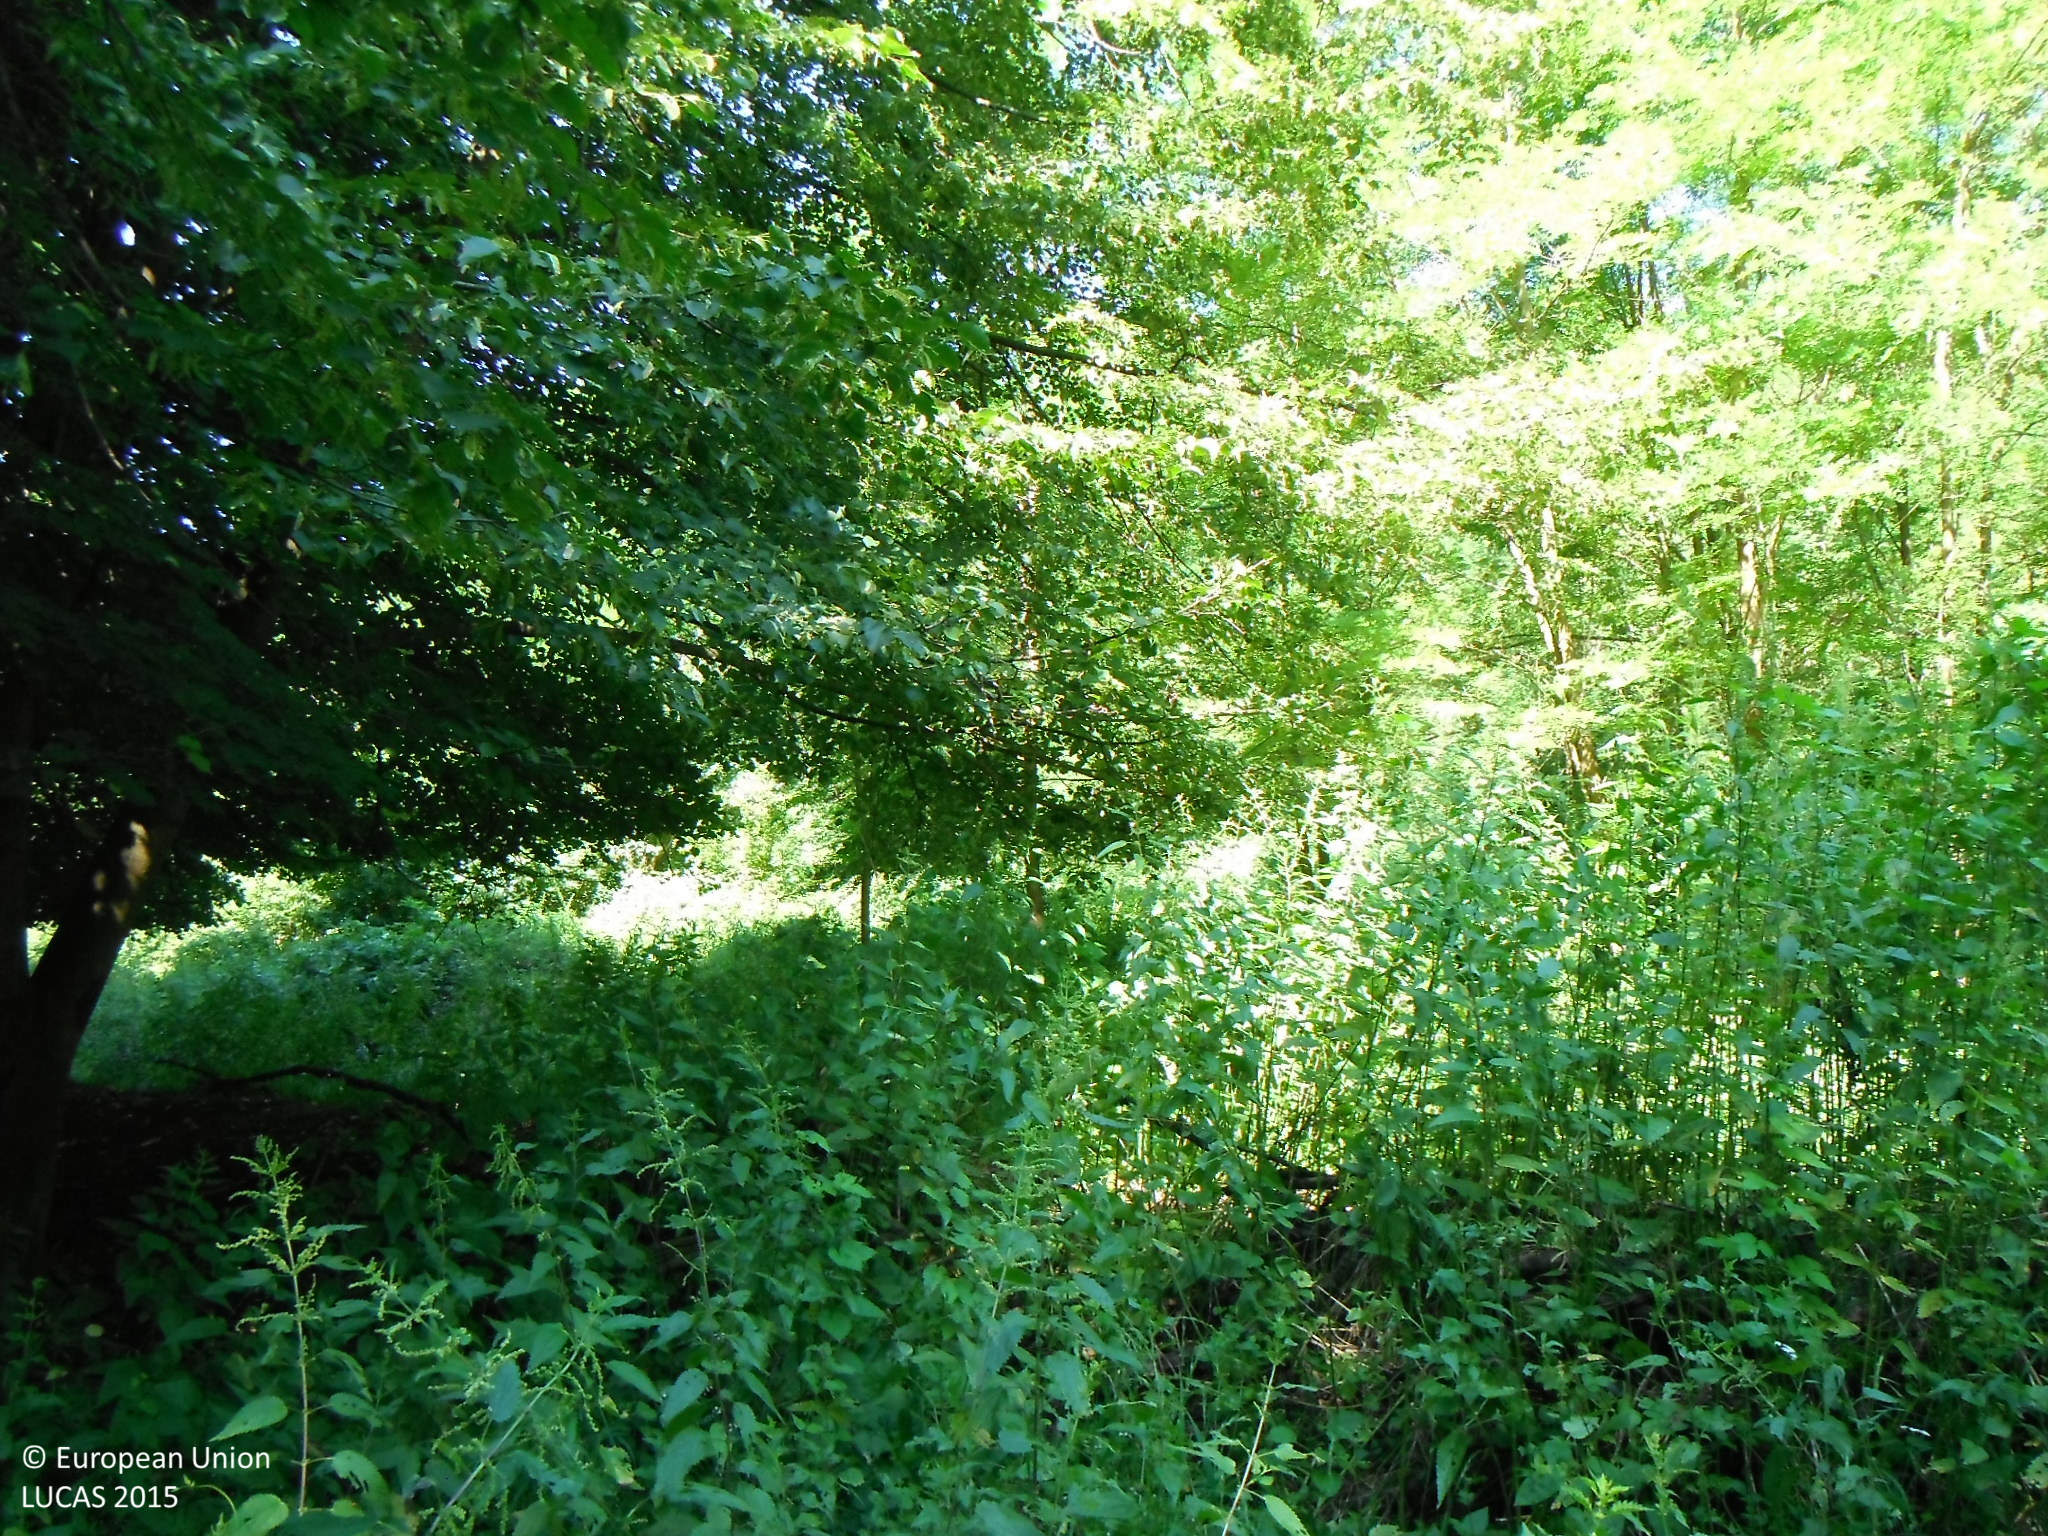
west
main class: Grassland
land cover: Spontaneously vegetated surfaces
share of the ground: > 75 %
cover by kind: herbaceous plants 95 %, shrubs 5 %
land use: Forestry
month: July
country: SK
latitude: 48.2619
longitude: 20.1469
